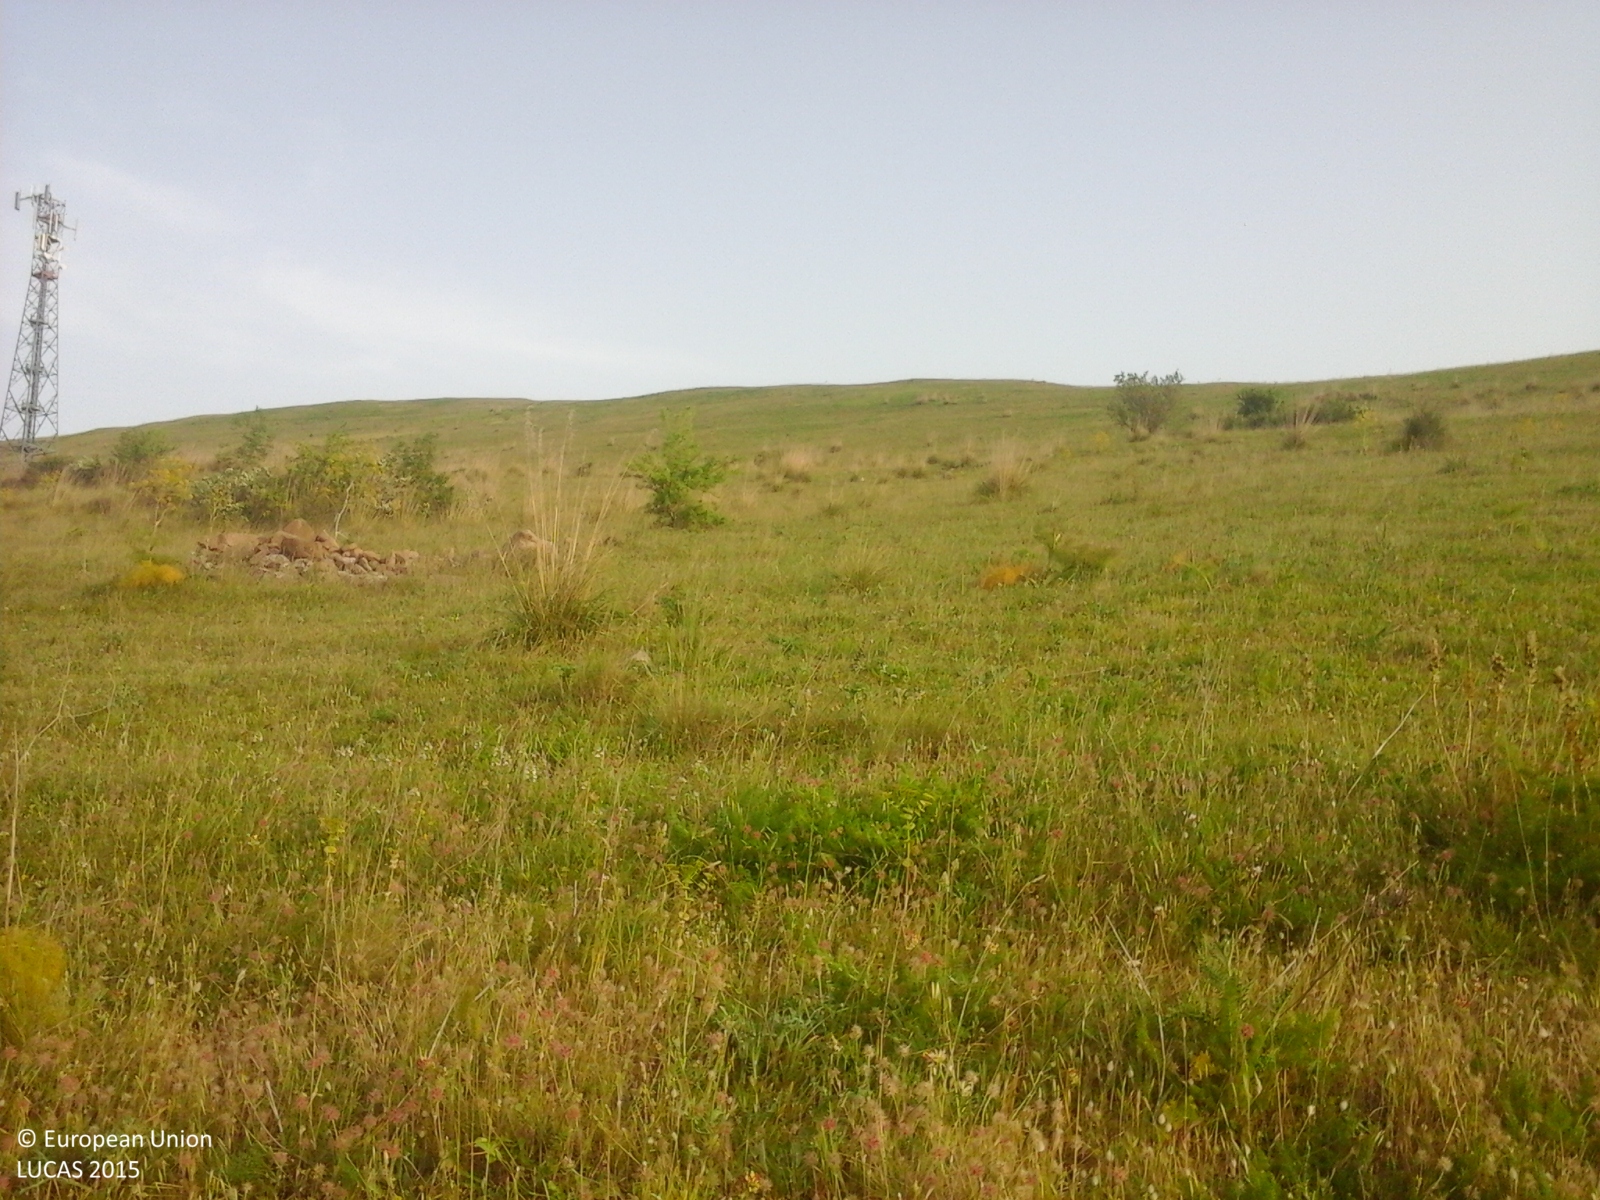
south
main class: Cropland
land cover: Durum wheat
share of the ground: > 75 %
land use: Agriculture (excluding fallow land and kitchen gardens)
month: May
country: IT
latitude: 37.7817
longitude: 14.2052
